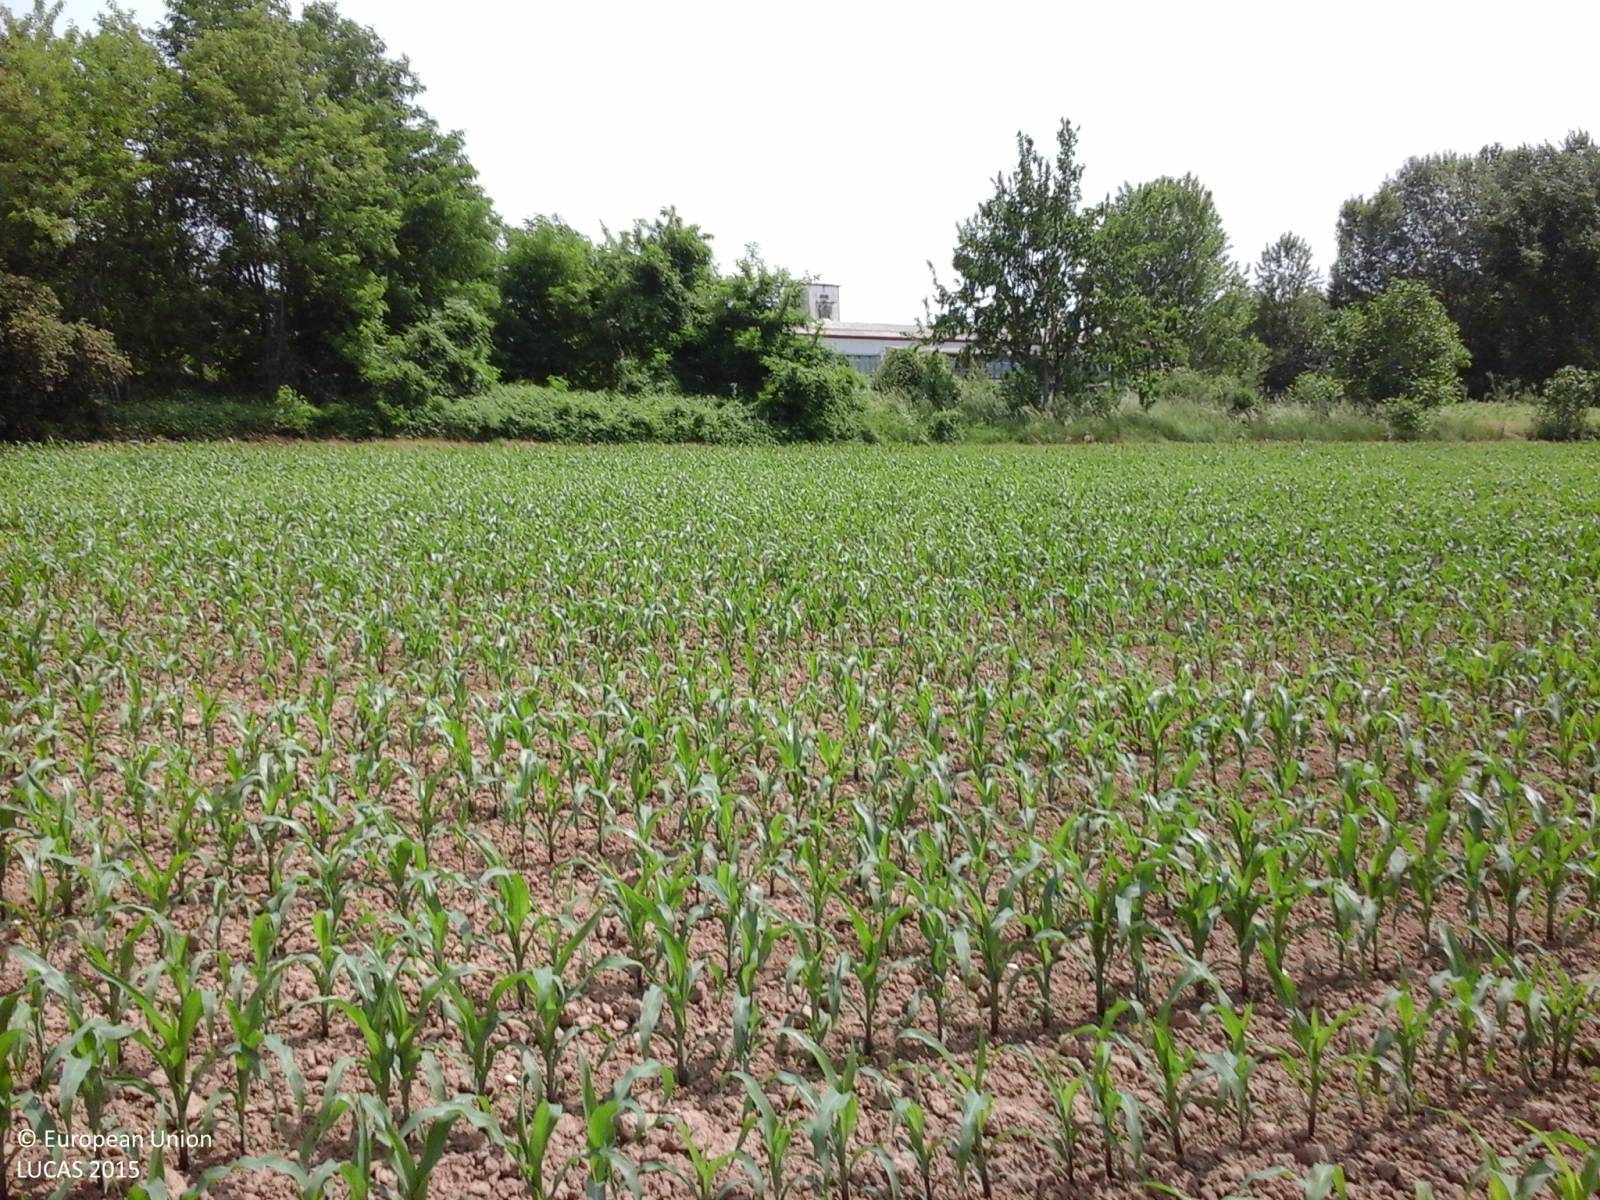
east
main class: Cropland
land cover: Maize
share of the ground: 25 - 50 %
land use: Agriculture (excluding fallow land and kitchen gardens)
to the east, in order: Maize; Grassland with sparse tree/shrub cover; Artificial constructions in urban areas
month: May
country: IT
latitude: 45.9754
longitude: 13.3133
